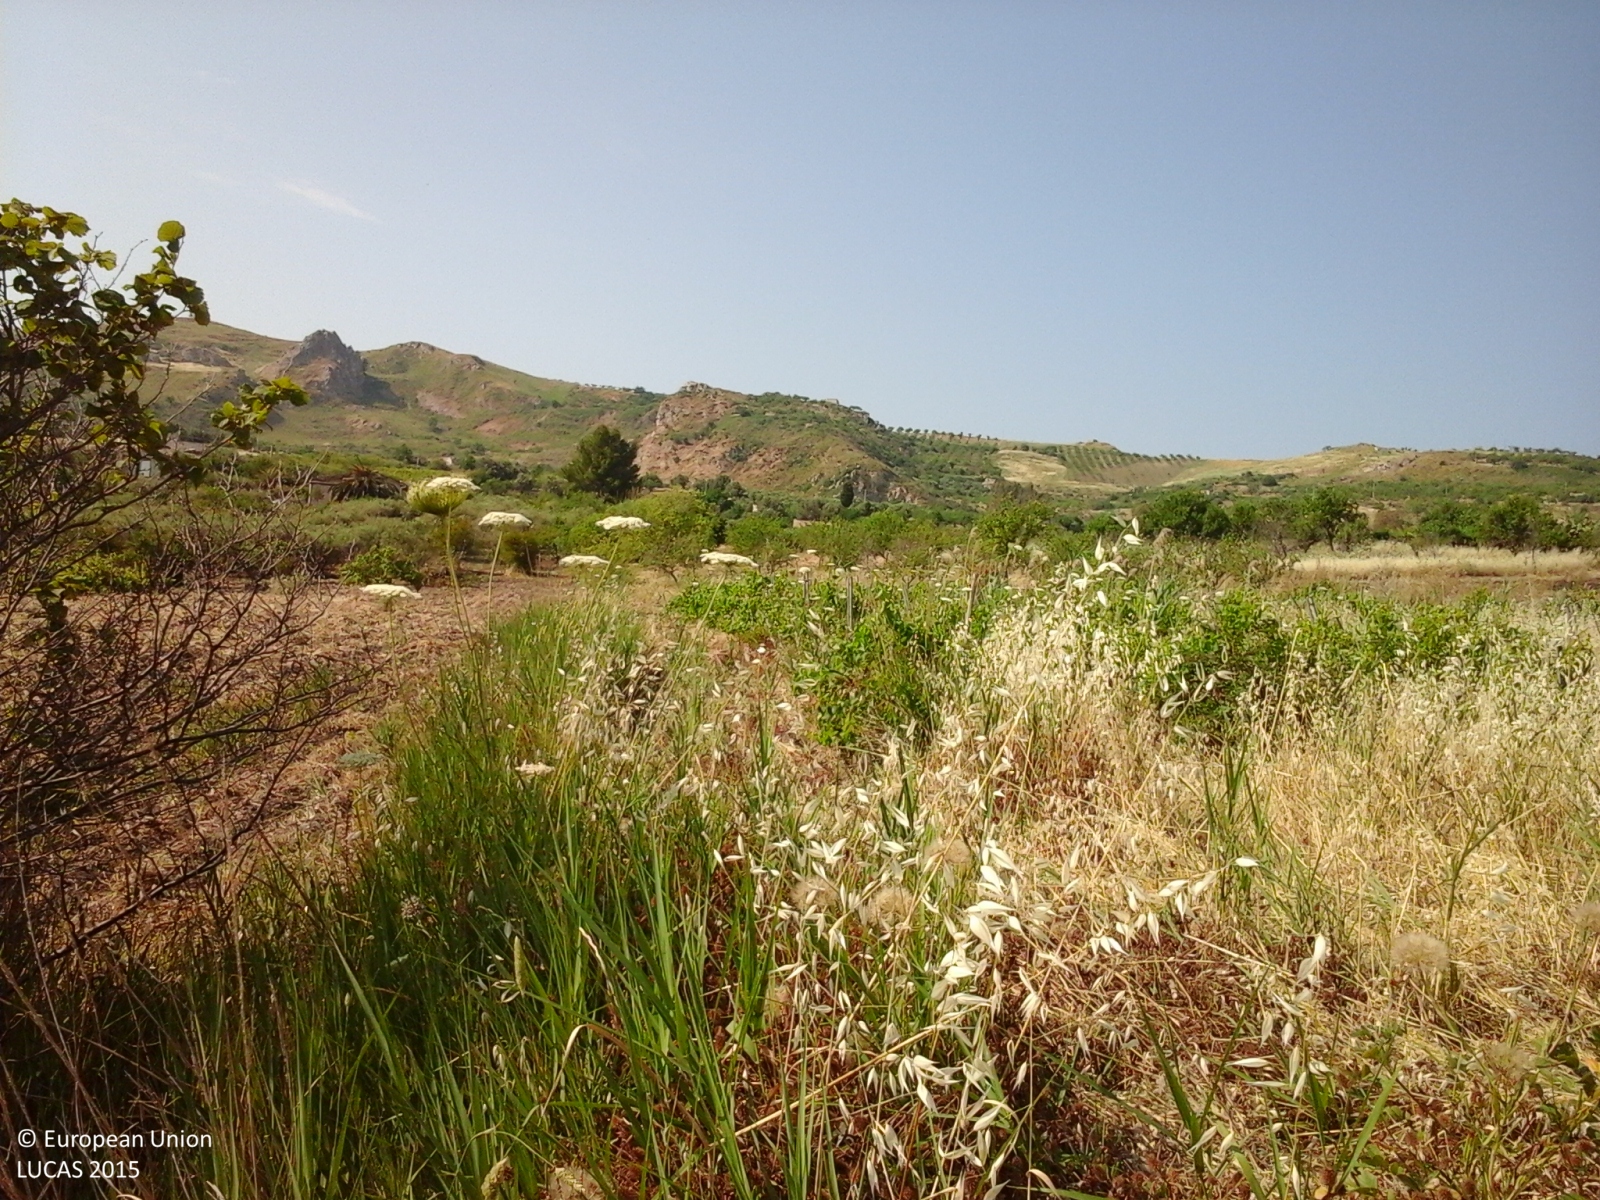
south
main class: Cropland
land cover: Olive groves
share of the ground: > 75 %
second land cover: Other bare soil
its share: > 75 %
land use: Agriculture (excluding fallow land and kitchen gardens)
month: June
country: IT
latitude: 37.3748
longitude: 13.4850
